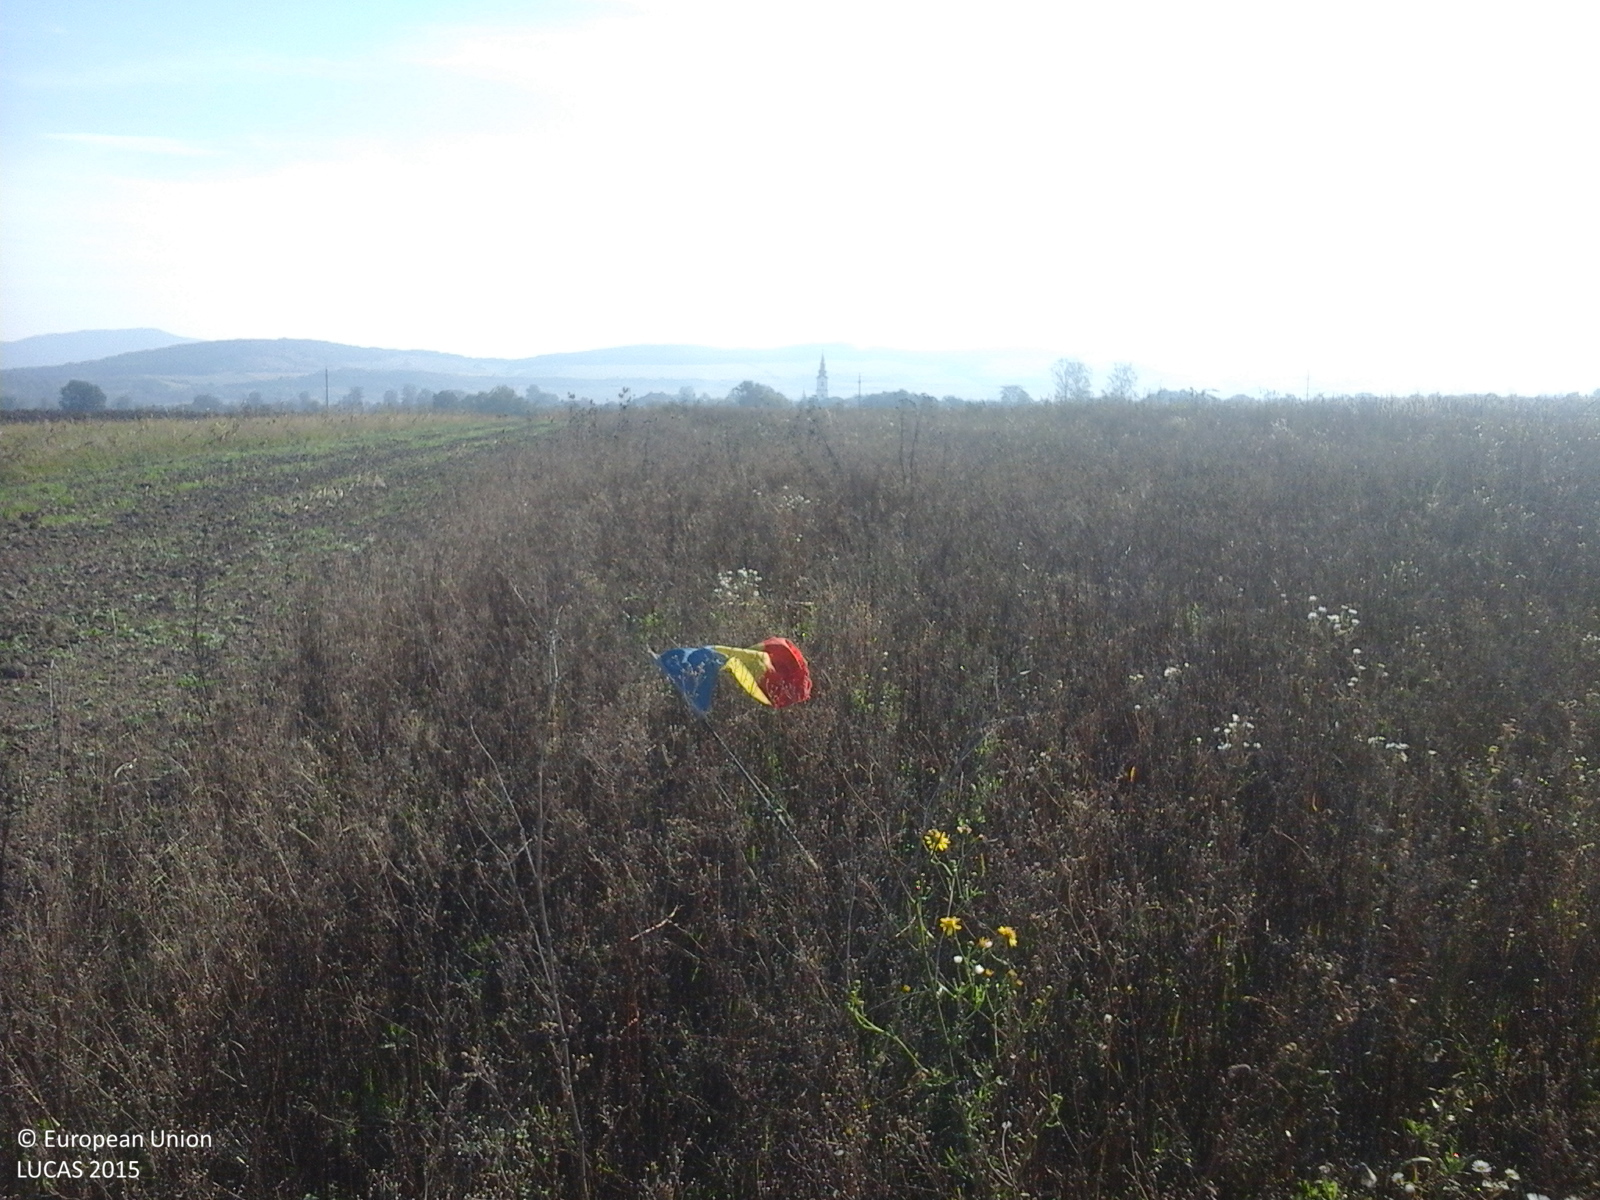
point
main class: Grassland
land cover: Spontaneously vegetated surfaces
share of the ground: > 75 %
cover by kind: herbaceous plants 100 %
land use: Agriculture (excluding fallow land and kitchen gardens)
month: September
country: RO
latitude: 47.1952
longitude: 22.6899
